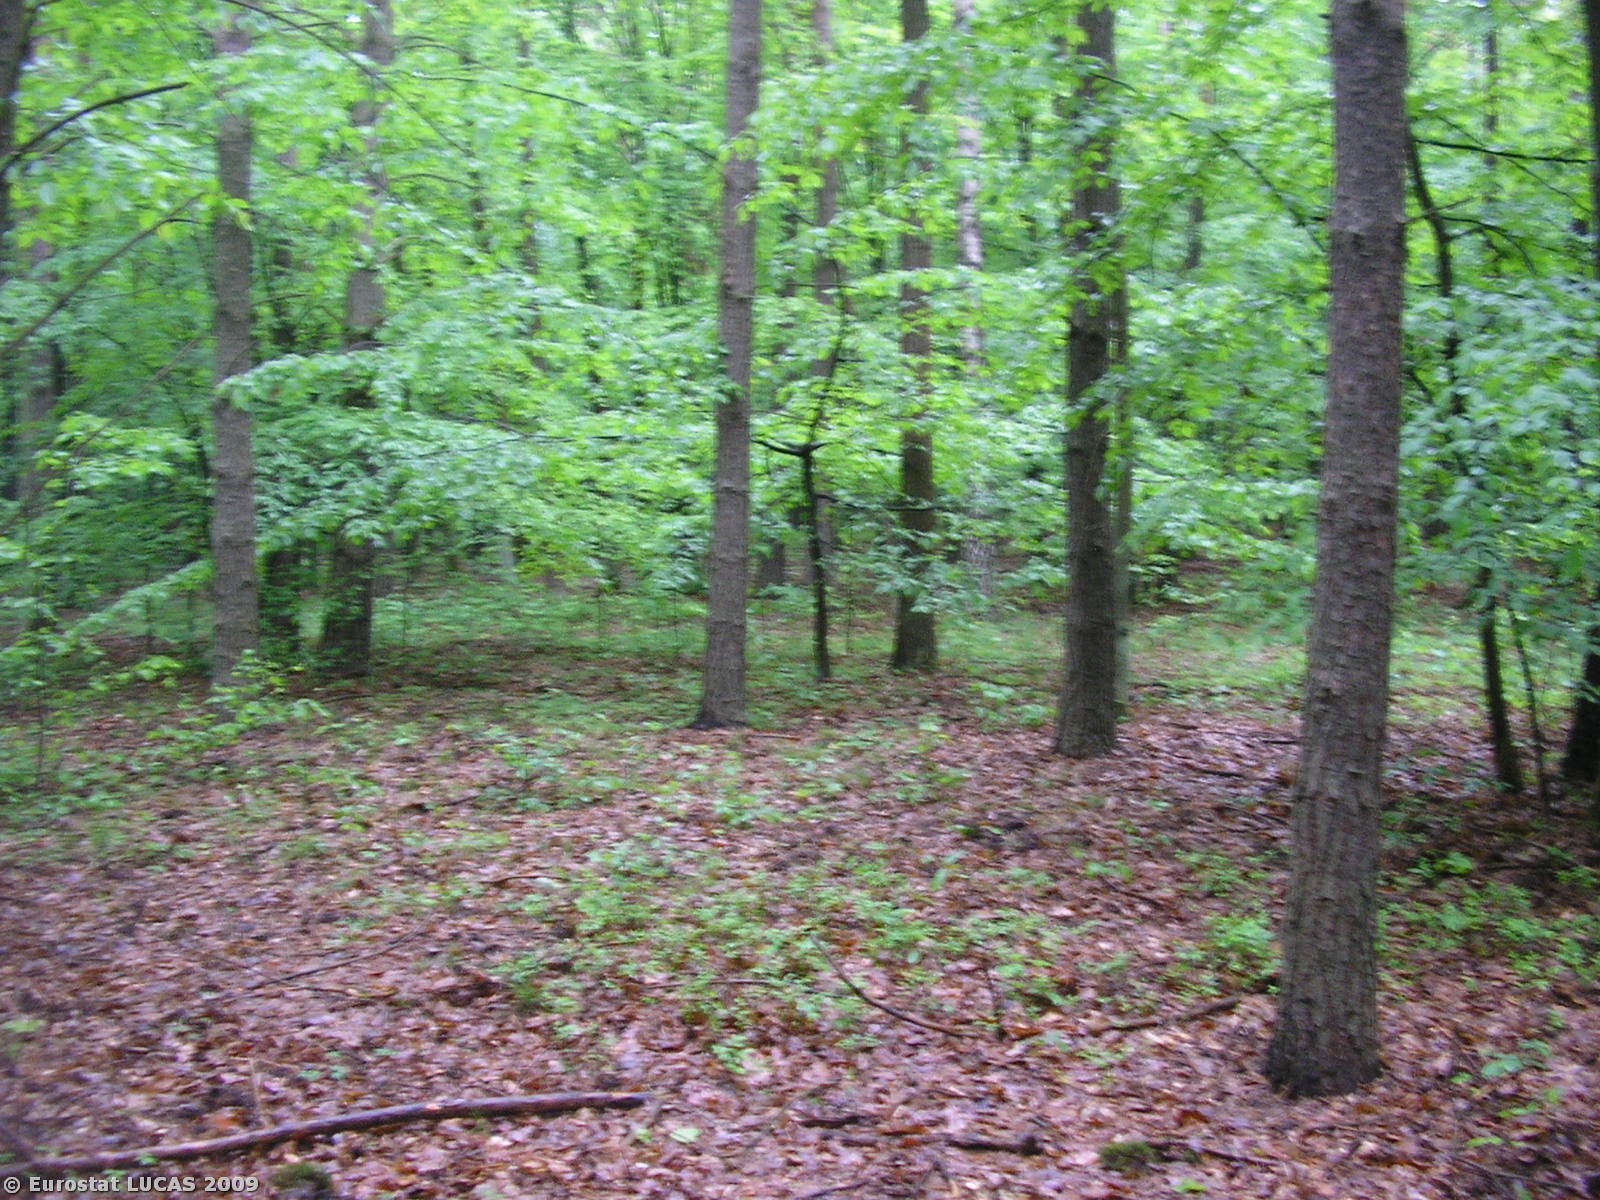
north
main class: Woodland
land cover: Broadleaved woodland
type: mesophytic deciduous forest
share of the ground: > 75 %
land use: Forestry
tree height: > 5 m
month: May
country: PL
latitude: 51.5936
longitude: 19.9785
